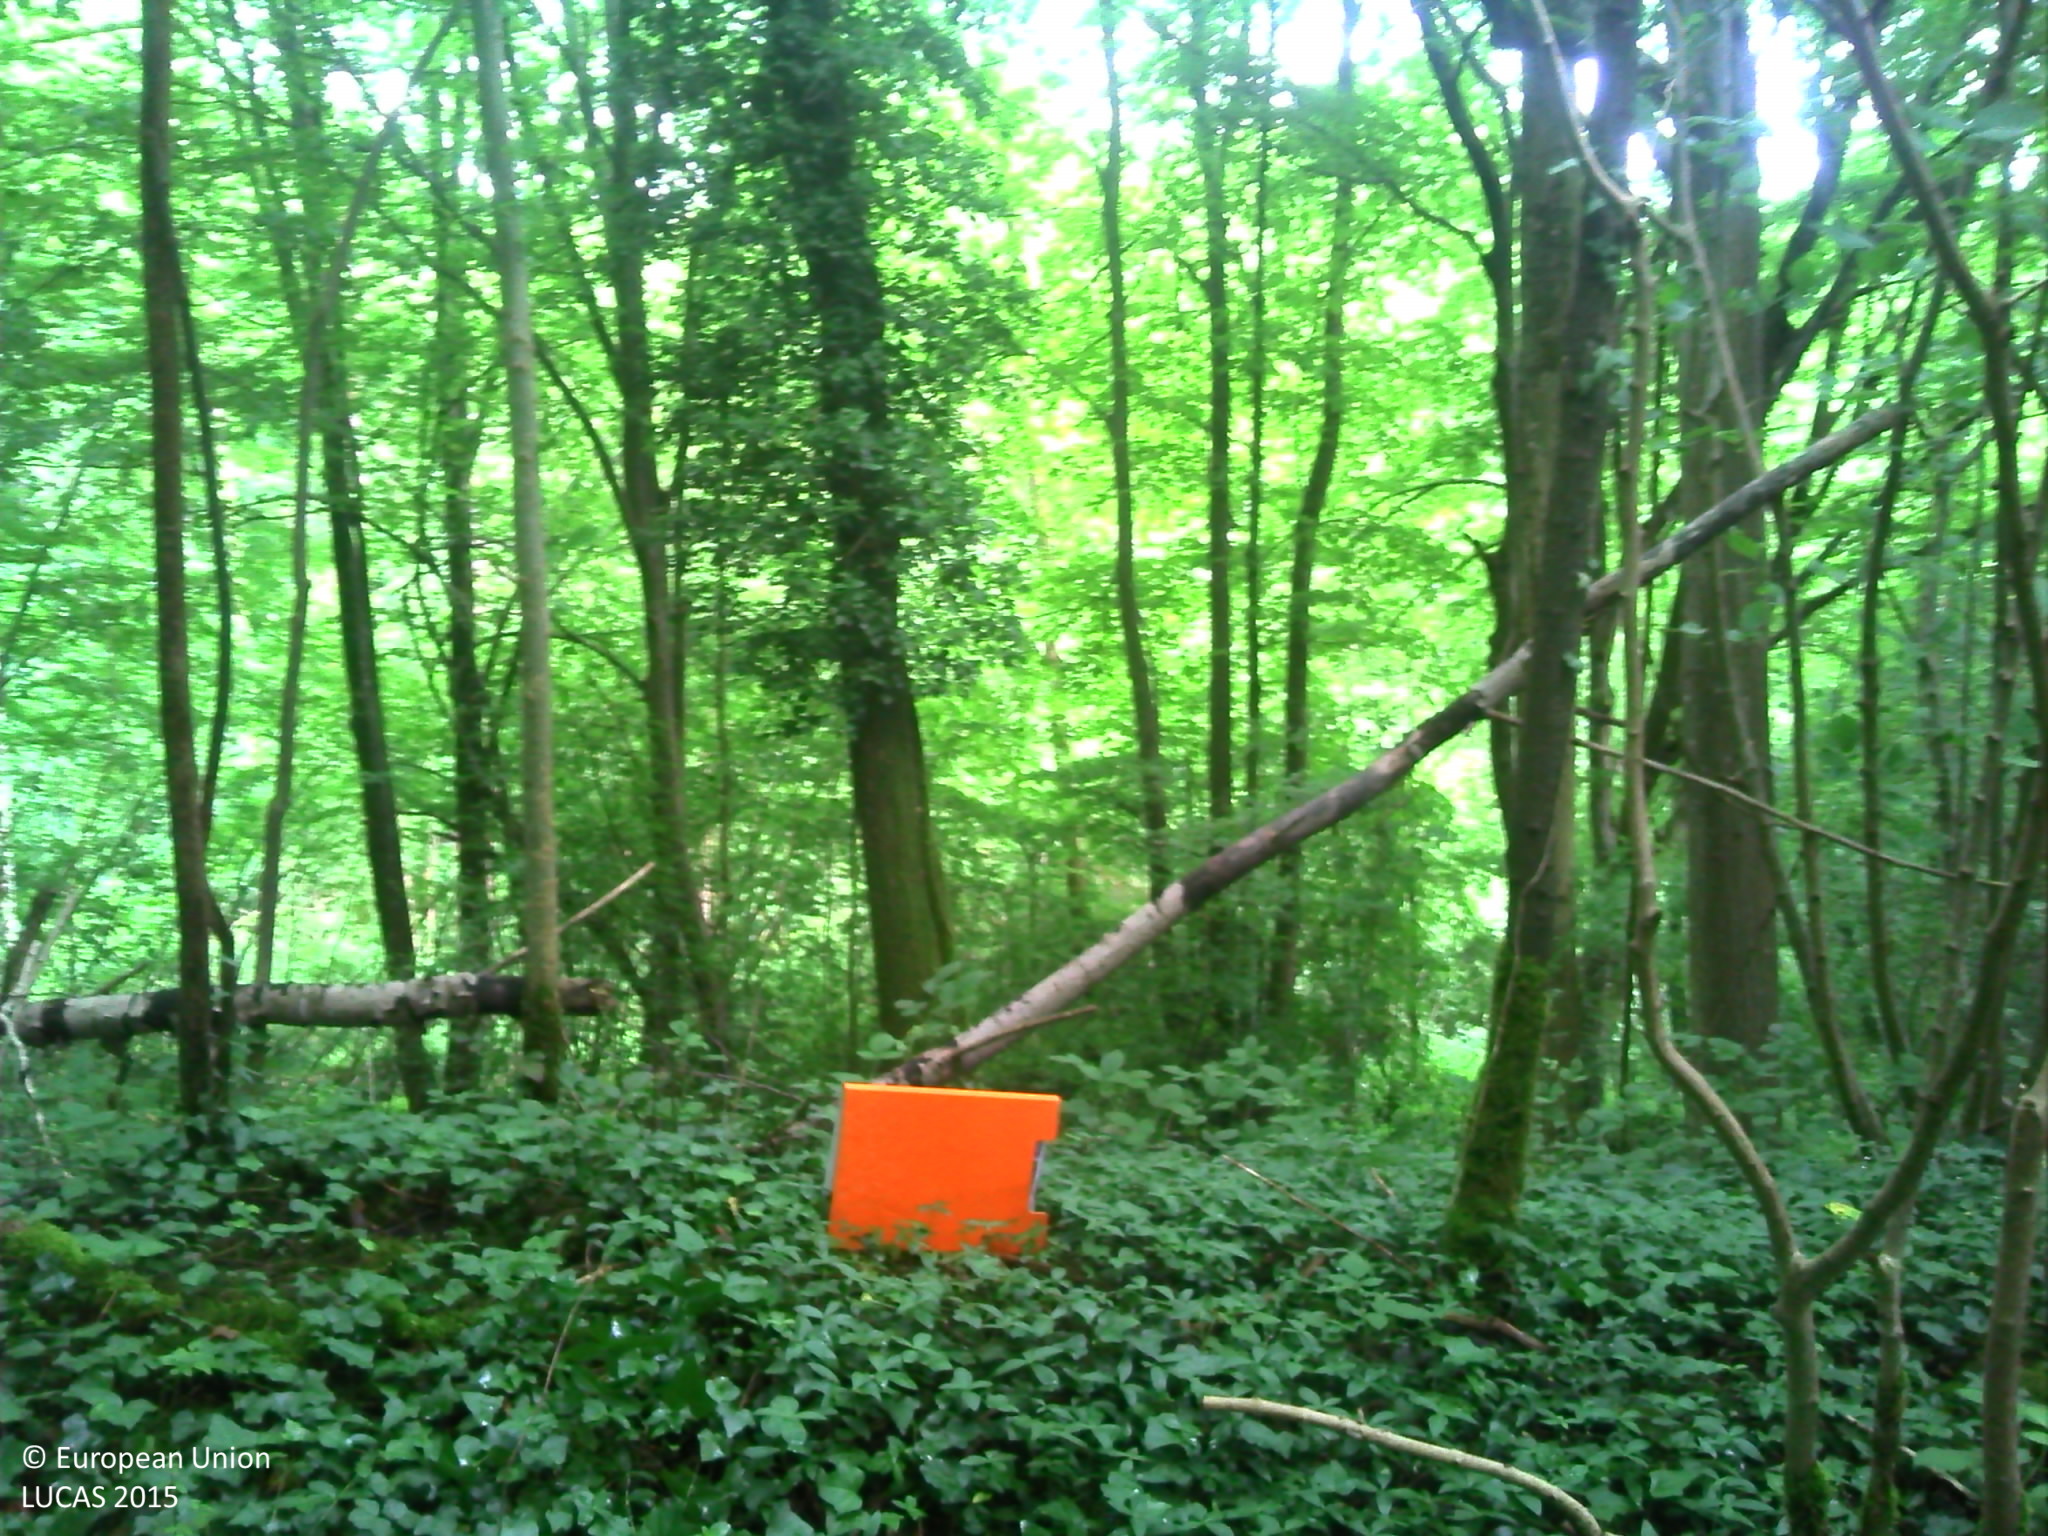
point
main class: Woodland
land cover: Broadleaved woodland
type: mesophytic deciduous forest
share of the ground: > 75 %
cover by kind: broadleaved forest trees 85 %, shrubs 10 %, herbaceous plants 5 %
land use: Forestry
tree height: > 5 m
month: June
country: FR
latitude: 49.5040
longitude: 3.6828
